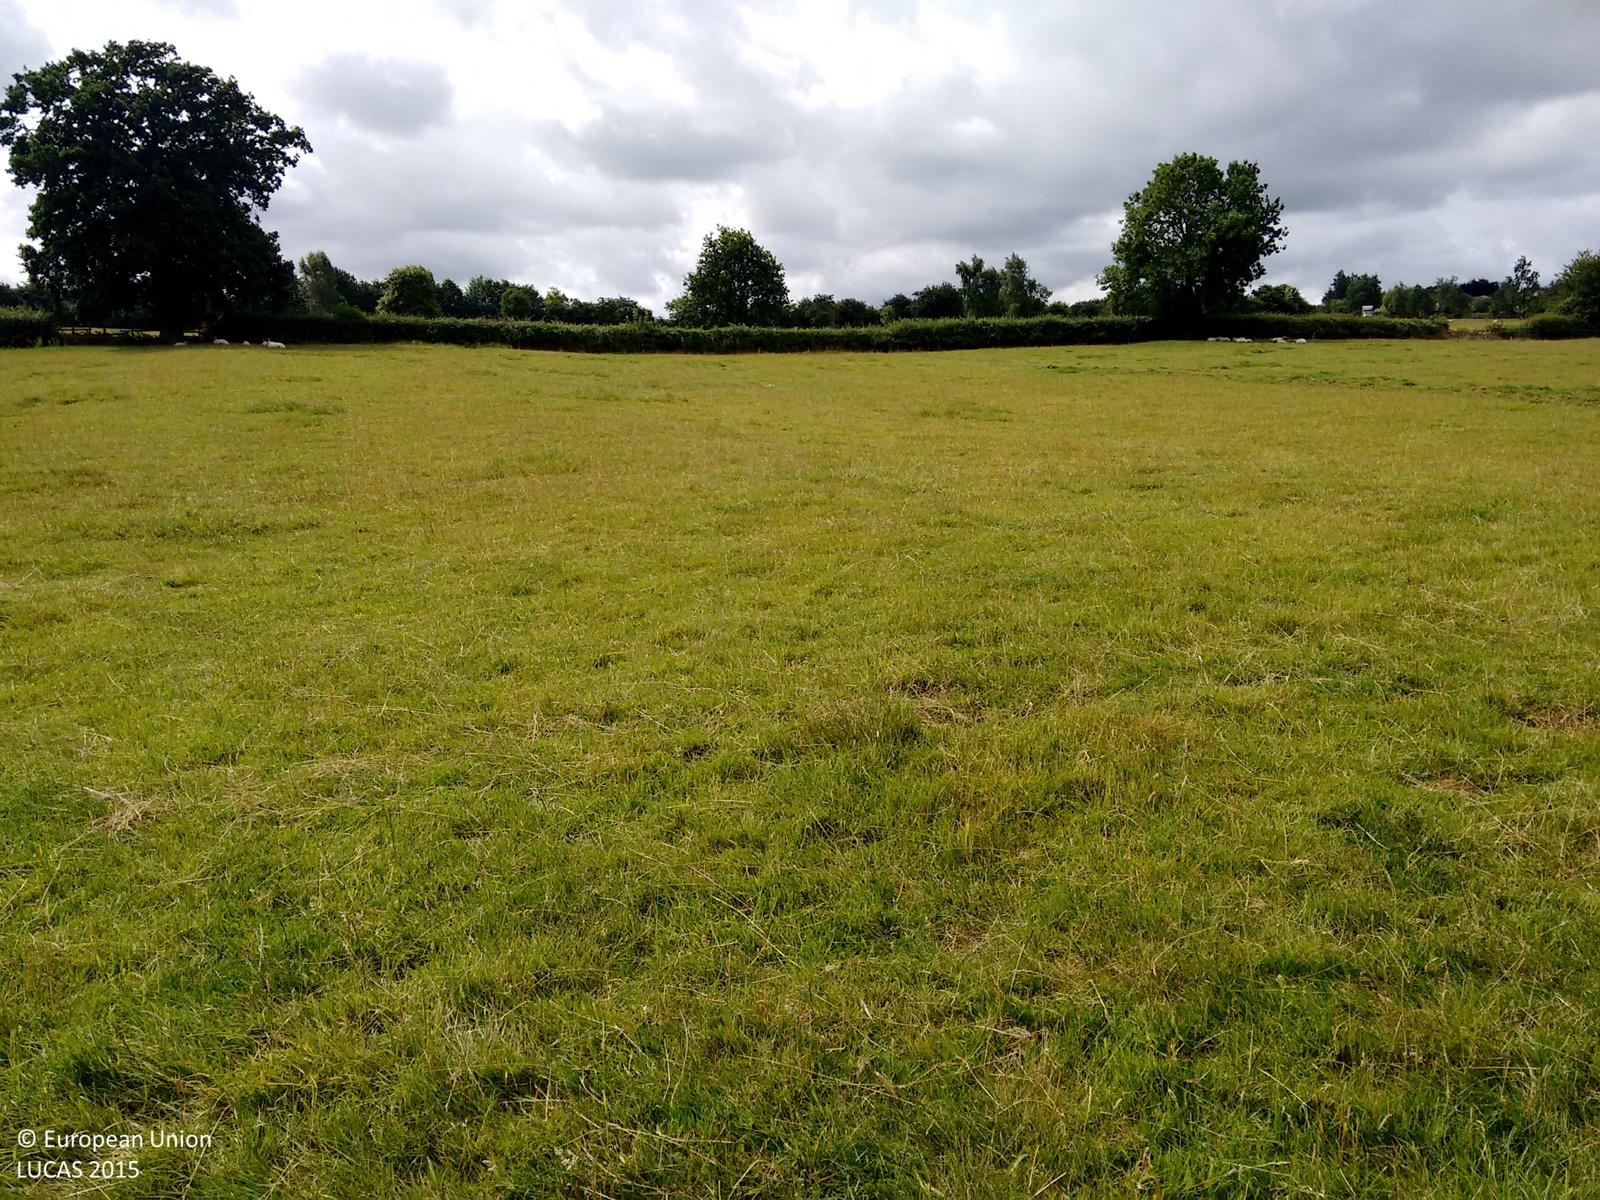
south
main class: Grassland
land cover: Grassland without tree/shrub cover
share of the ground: > 75 %
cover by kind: herbaceous plants 100 %
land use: Agriculture (excluding fallow land and kitchen gardens)
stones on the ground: < 10 %
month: July
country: GB
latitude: 52.6367
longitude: -0.6943
